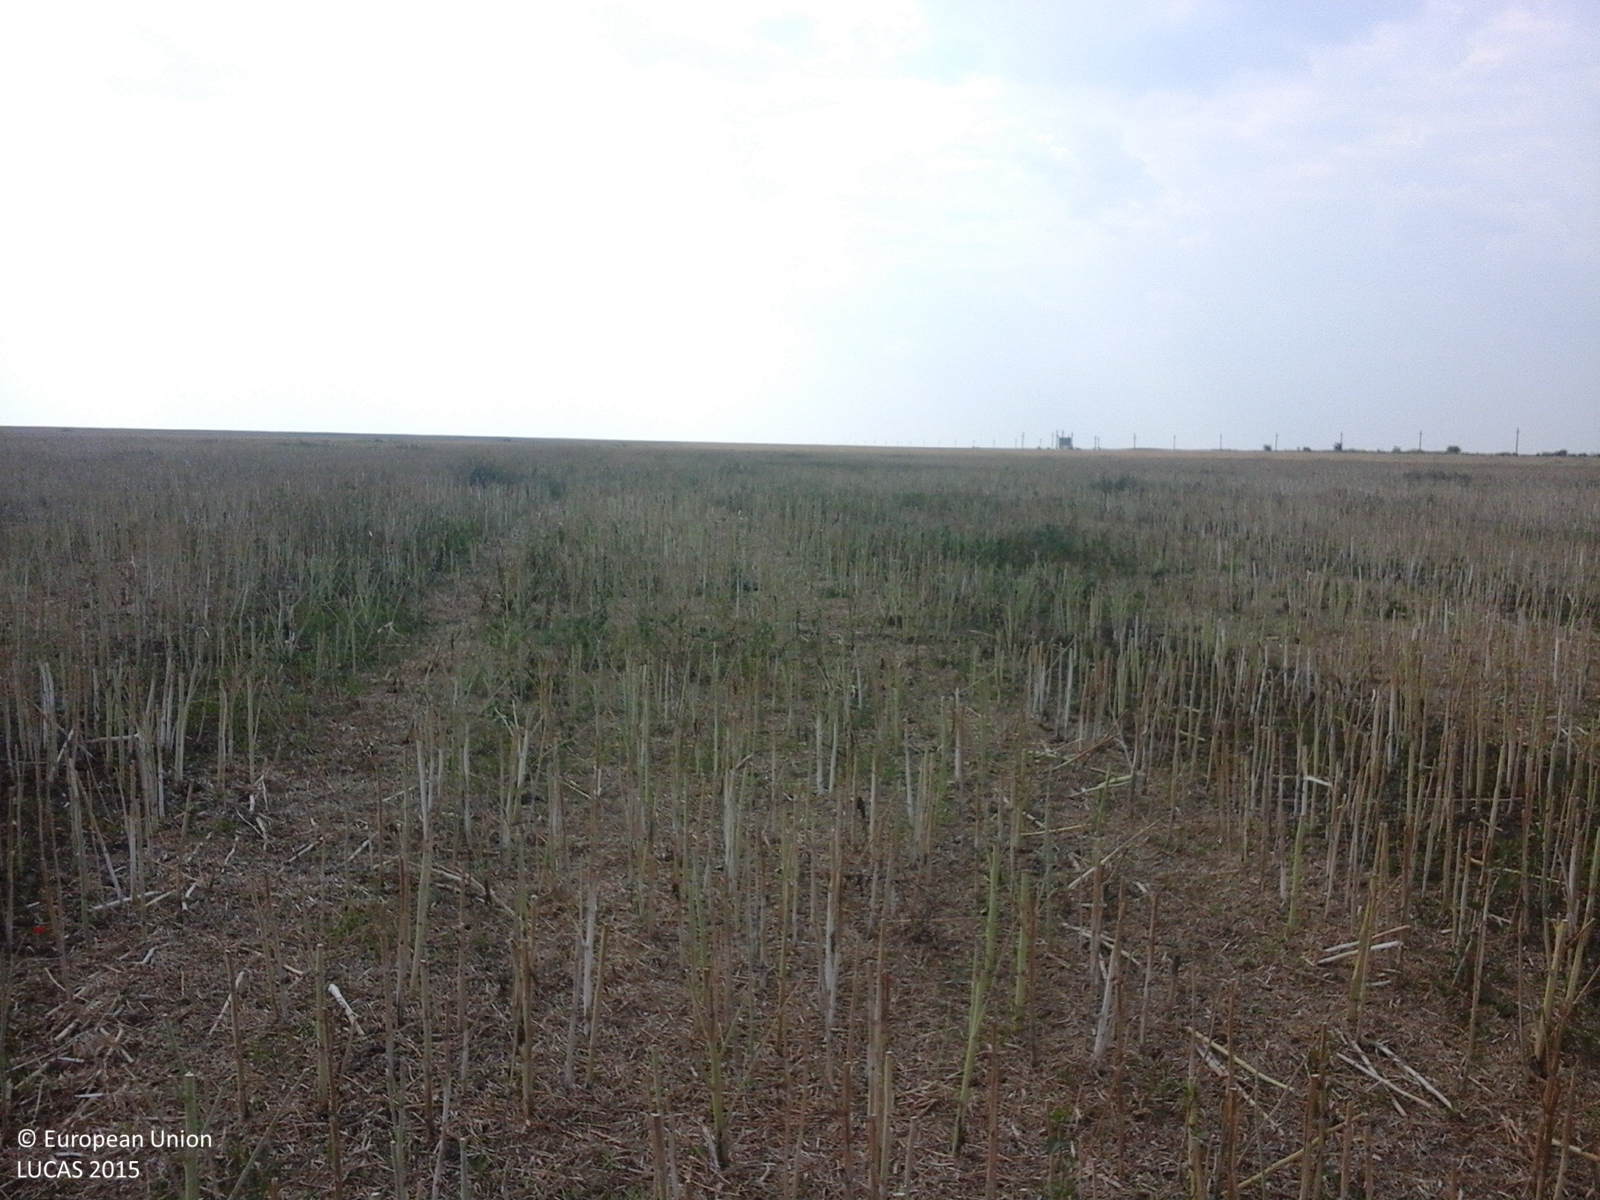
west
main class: Cropland
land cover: Rape and turnip rape
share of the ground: < 10 %
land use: Agriculture (excluding fallow land and kitchen gardens)
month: July
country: RO
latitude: 43.8801
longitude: 24.8452
